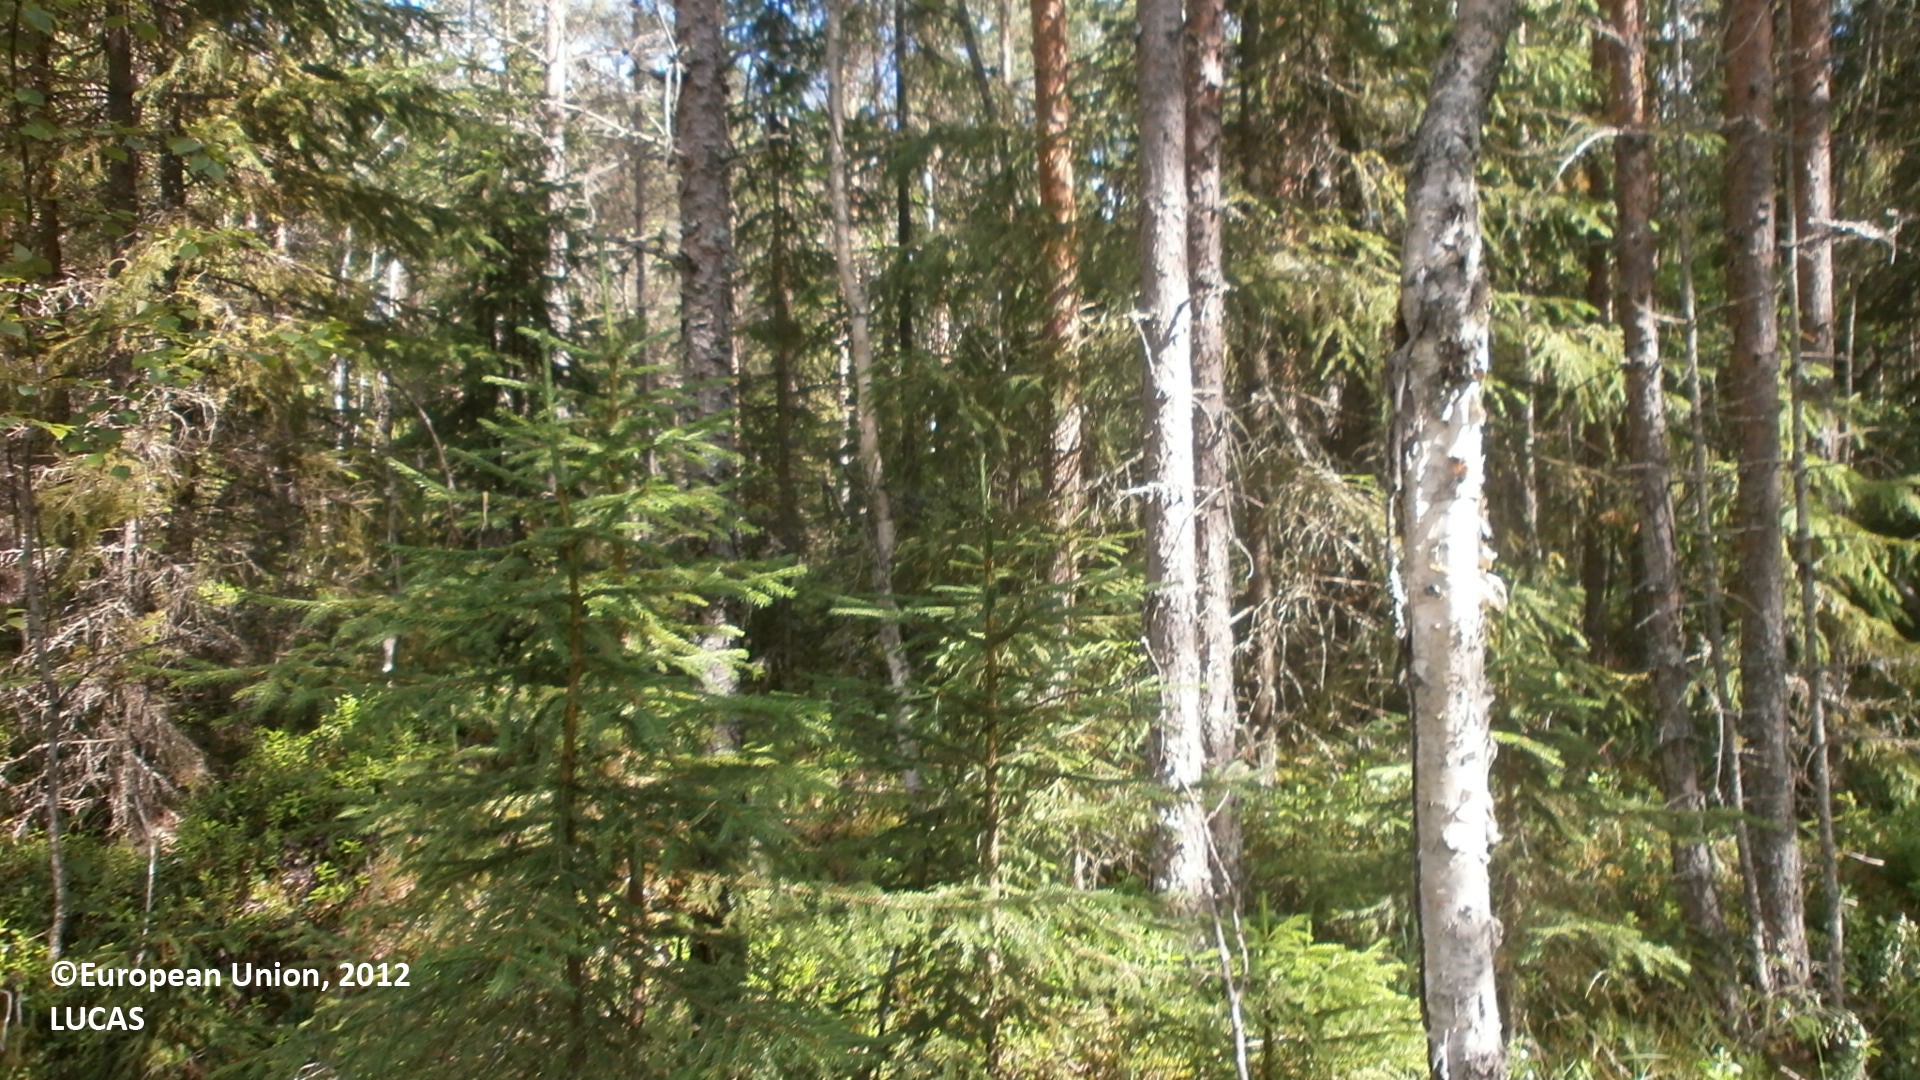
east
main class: Woodland
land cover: Pine dominated coniferous woodland
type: boreal forest
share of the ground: 50 - 75 %
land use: Forestry
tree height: > 5 m
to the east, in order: Pine dominated coniferous woodland; Spruce dominated coniferous woodland; Pine dominated coniferous woodland; Broadleaved woodland; Shruby margins; Tracks; Shruby margins; Broadleaved woodland; Ditches and canals; Broadleaved woodland; Ditches and canals; Broadleaved woodland; Pine dominated mixed woodland
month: July
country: FI
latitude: 63.9851
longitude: 23.8983
